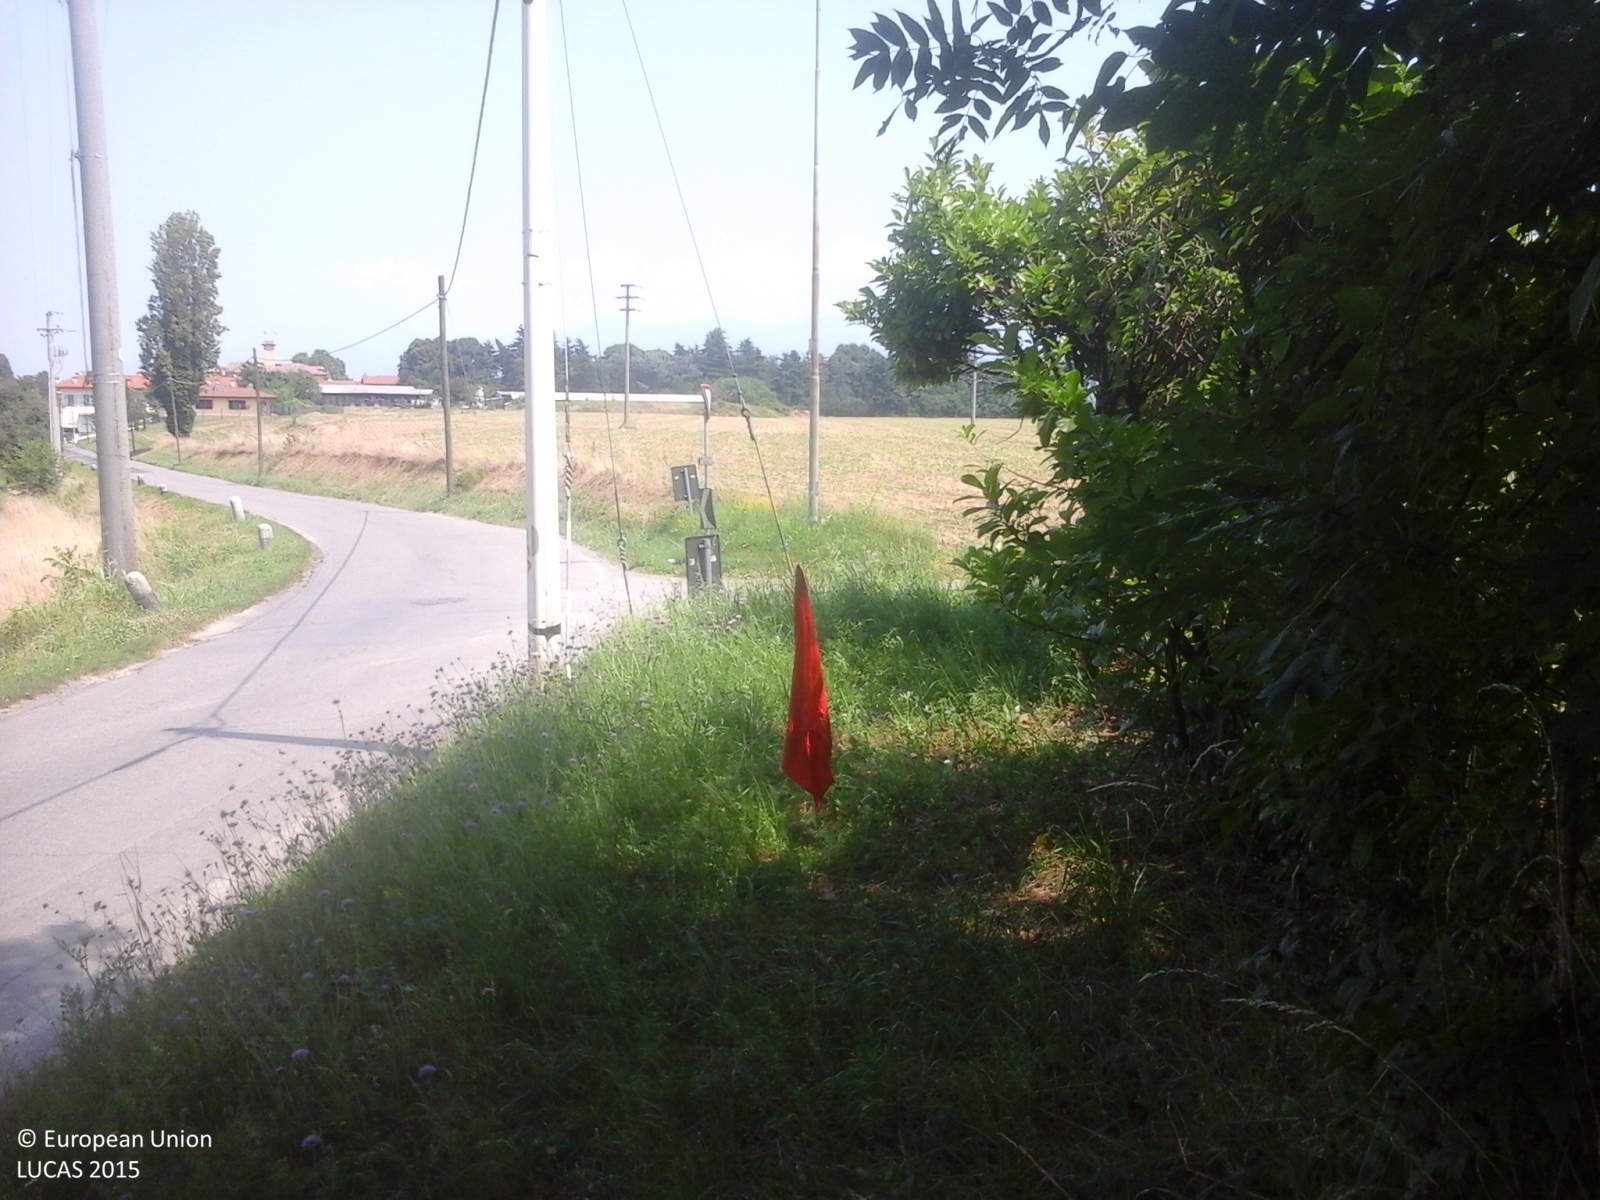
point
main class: Grassland
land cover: Grassland without tree/shrub cover
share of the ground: > 75 %
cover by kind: herbaceous plants 100 %
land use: Agriculture (excluding fallow land and kitchen gardens)
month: July
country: IT
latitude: 45.6470
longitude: 9.4236
